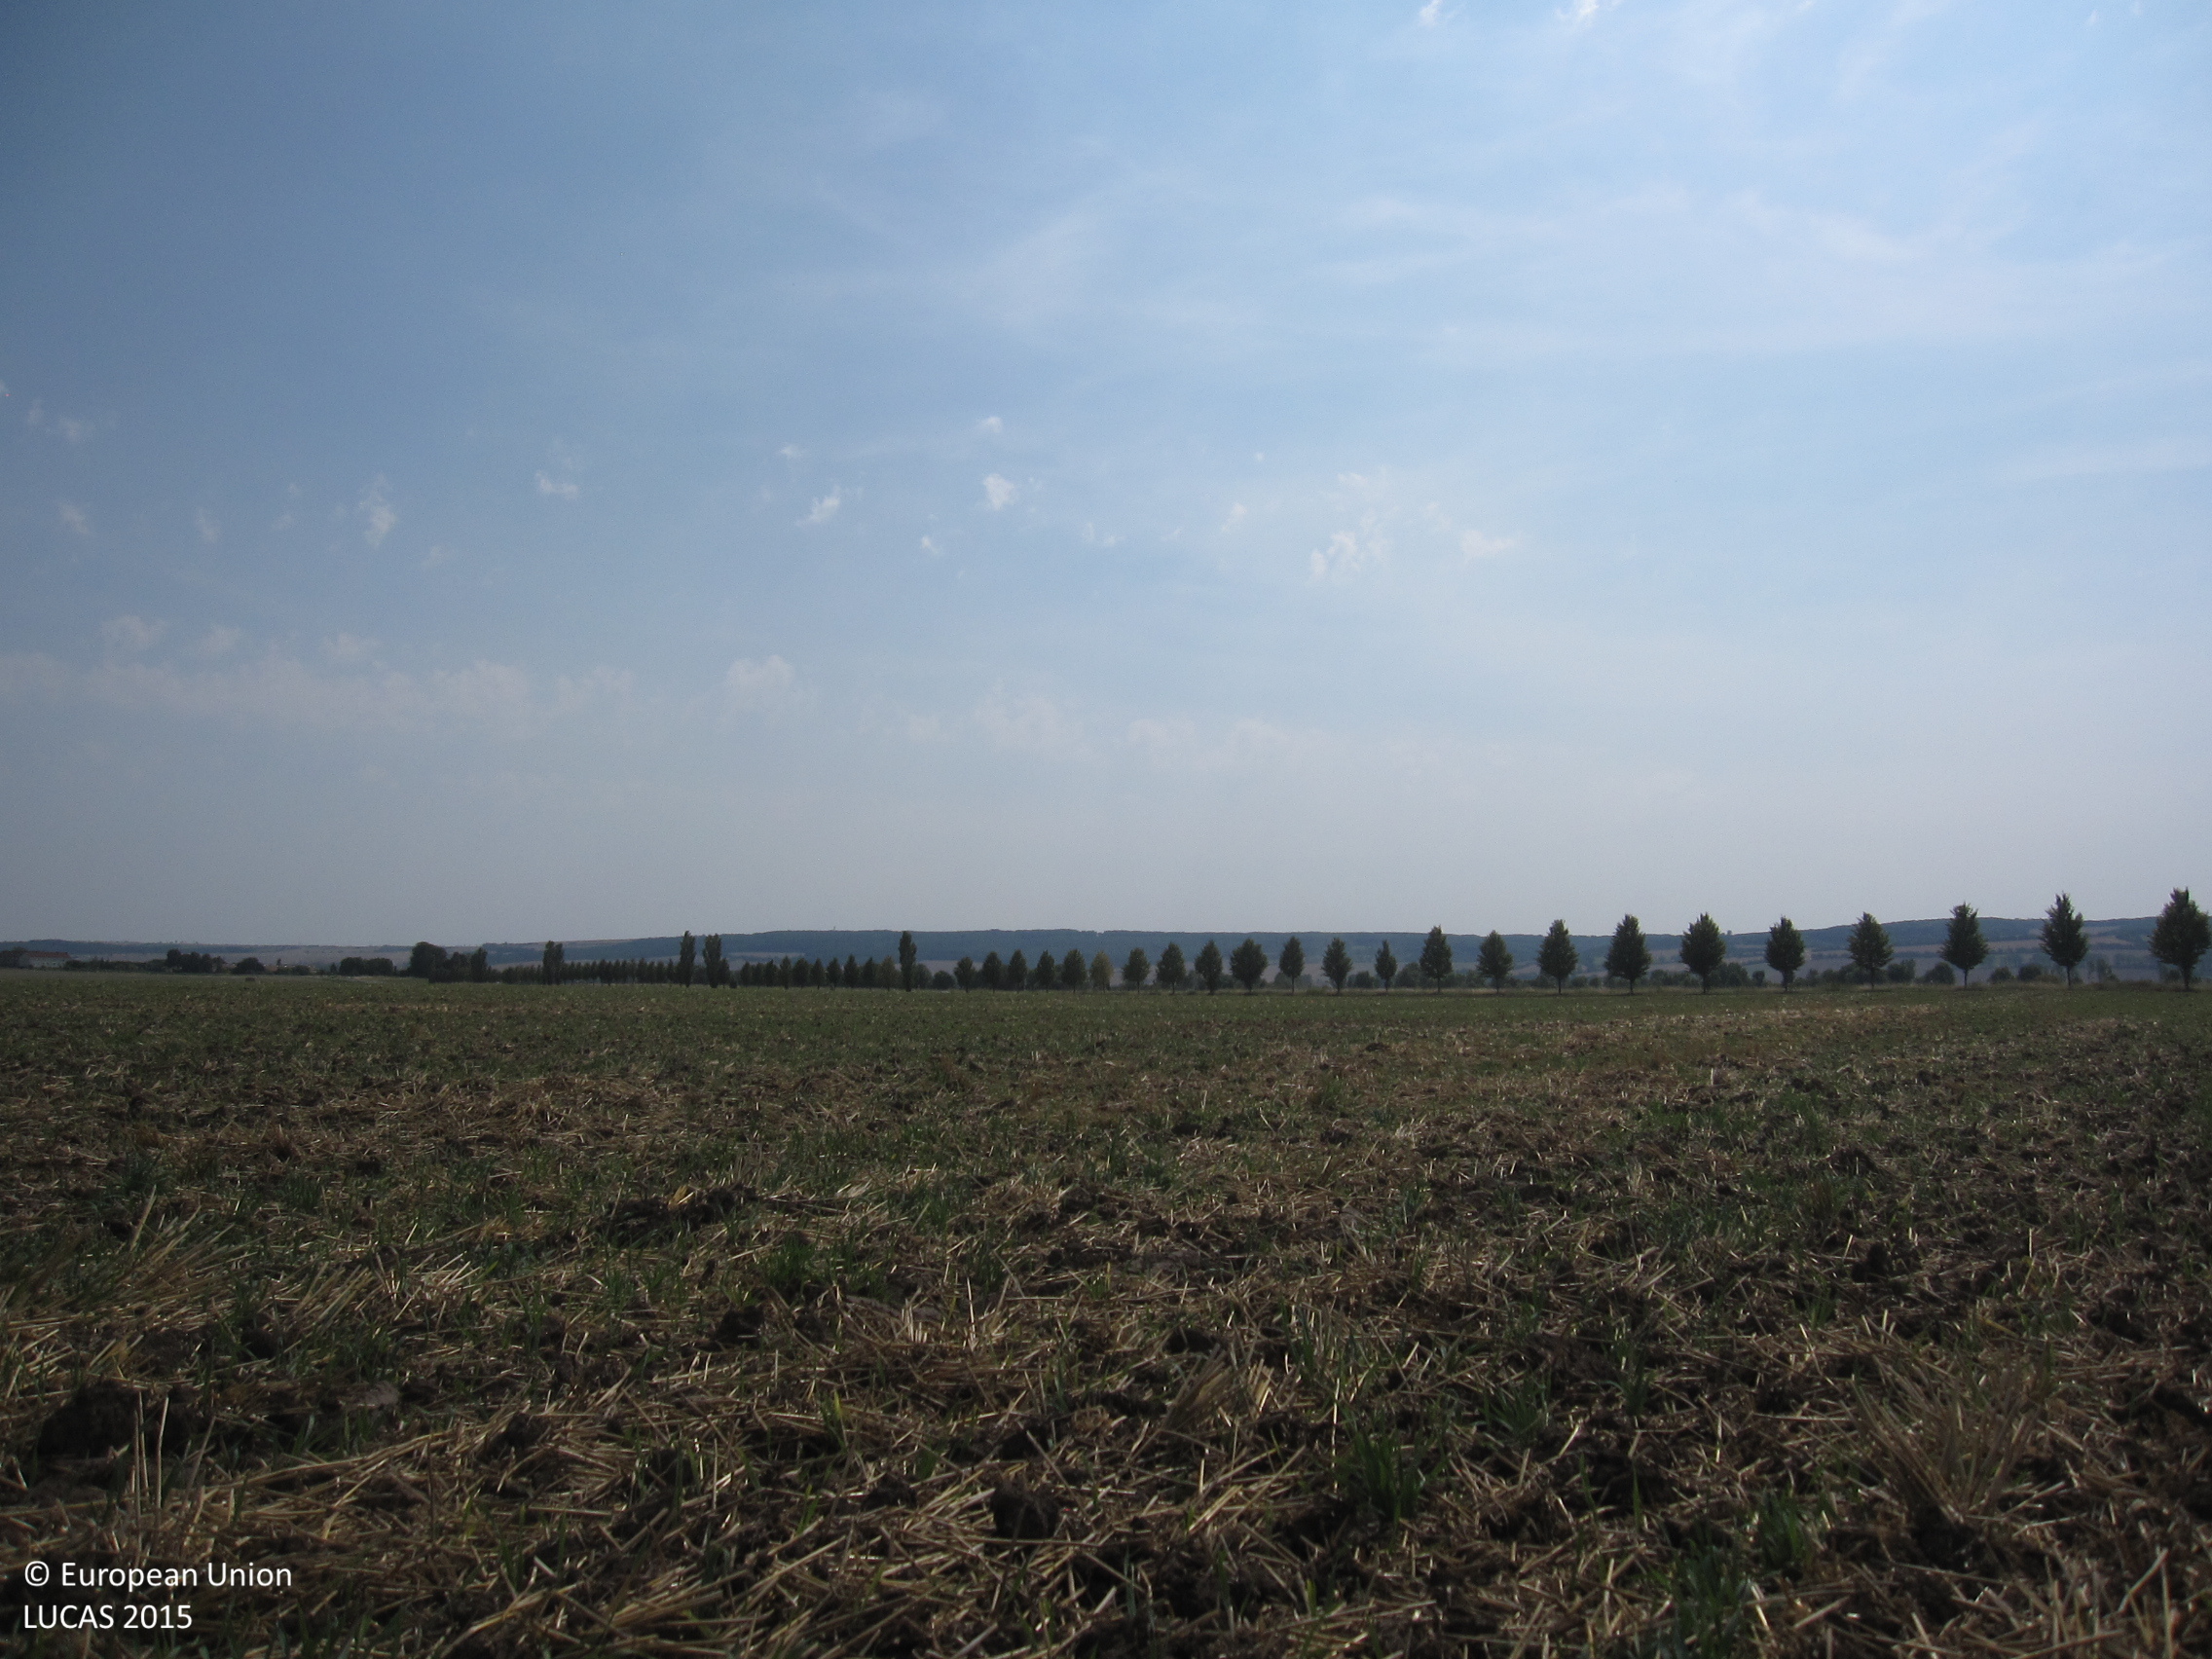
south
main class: Cropland
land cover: Common wheat
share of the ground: 10 - 25 %
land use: Agriculture (excluding fallow land and kitchen gardens)
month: August
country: DE
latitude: 51.2899
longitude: 11.4479
